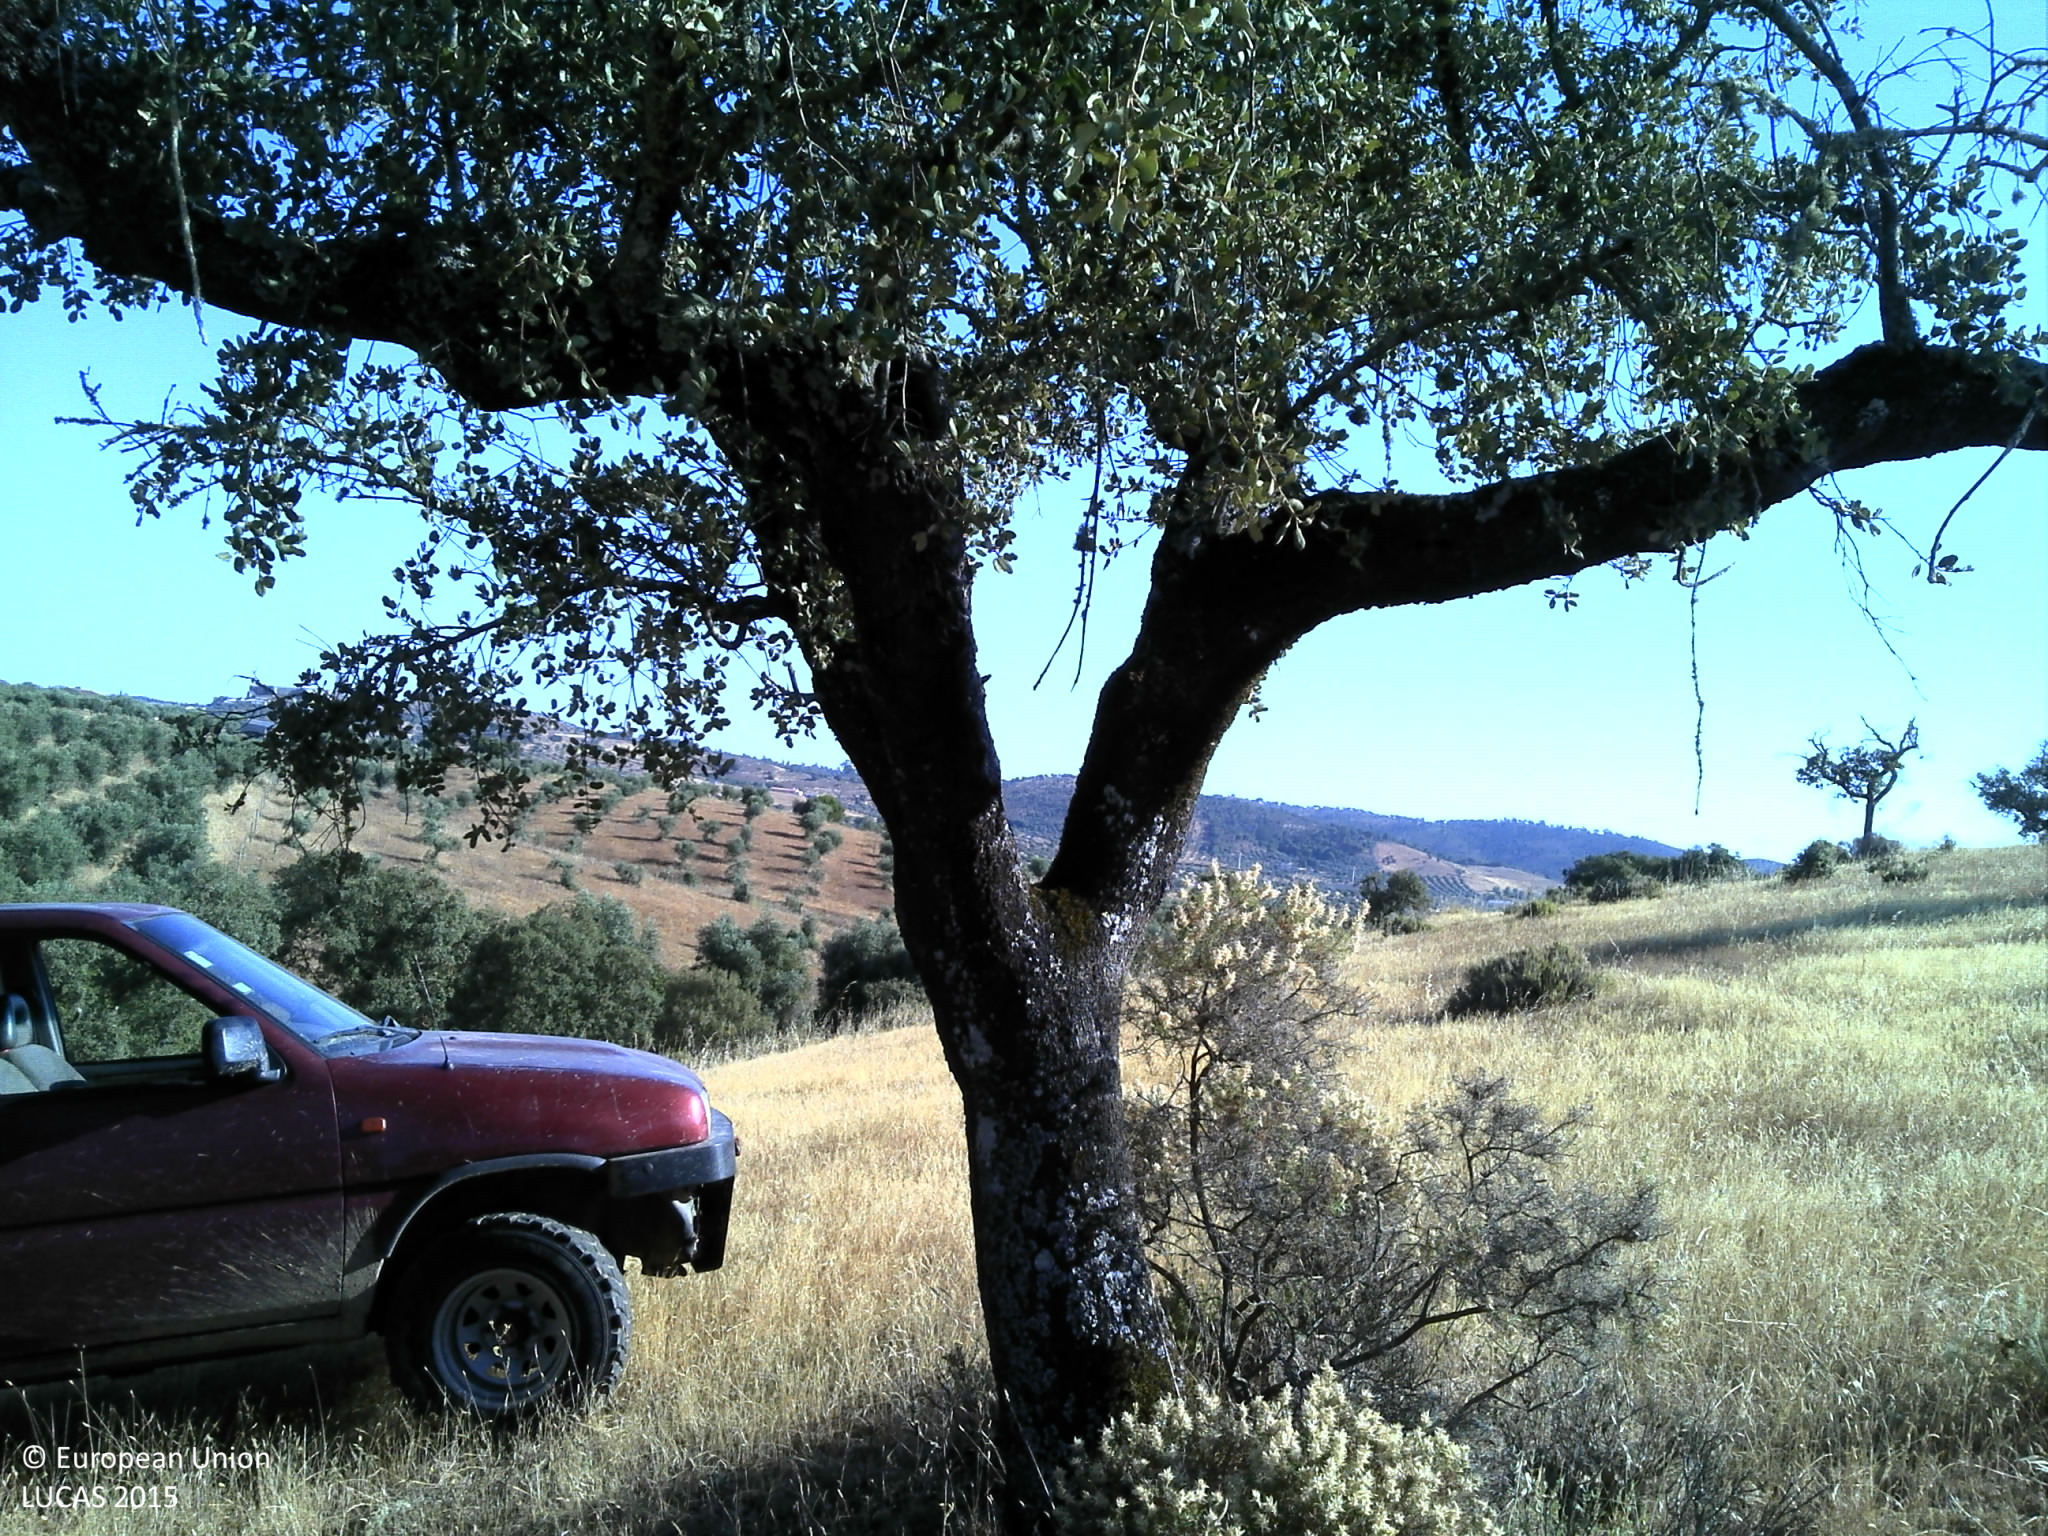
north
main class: Woodland
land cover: Broadleaved woodland
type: broadleaved evergreen forest
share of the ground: 10 - 25 %
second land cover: Grassland without tree/shrub cover
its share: 25 - 50 %
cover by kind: herbaceous plants 50 %, unconsolidated bare surface 35 %, broadleaved forest trees 15 %
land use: Forestry
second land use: Agriculture (excluding fallow land and kitchen gardens)
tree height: > 5 m
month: June
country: PT
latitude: 38.2934
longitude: -7.6943
